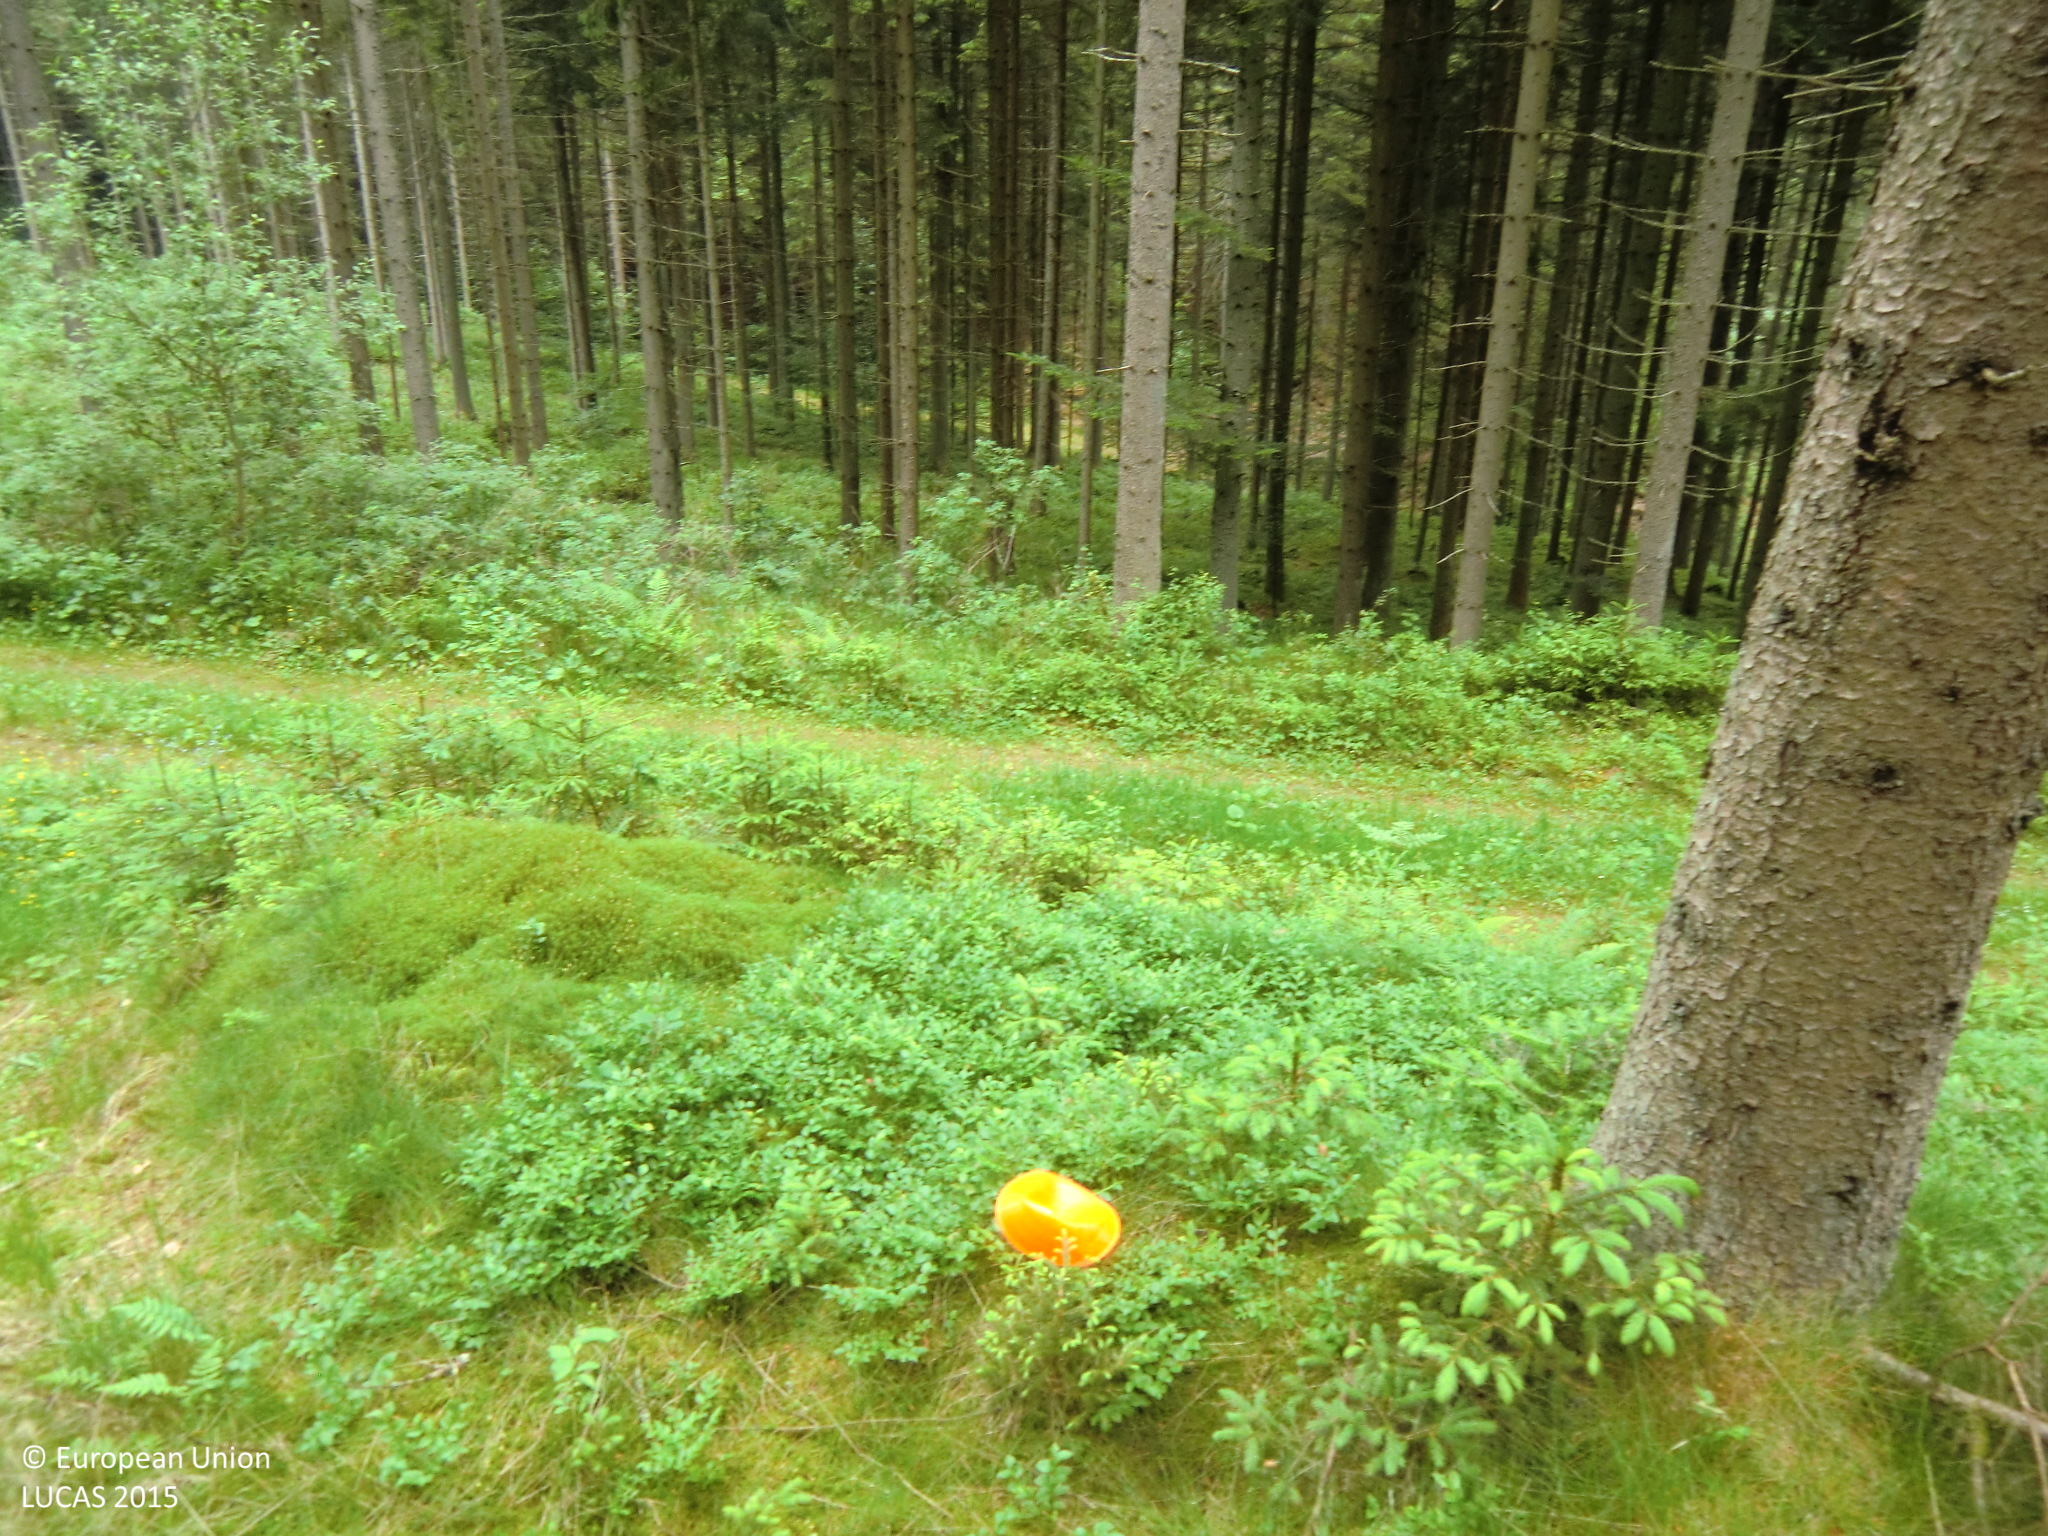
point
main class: Woodland
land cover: Spruce dominated coniferous woodland
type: hemiboreal forest and nemoral coniferous forest and mixed broadleaved-coniferous forest
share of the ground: 50 - 75 %
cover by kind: coniferous forest trees 60 %, shrubs 15 %, herbaceous plants 15 %, lichens and mosses 10 %
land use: Forestry
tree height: > 5 m
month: June
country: AT
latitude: 48.3693
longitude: 14.8473
